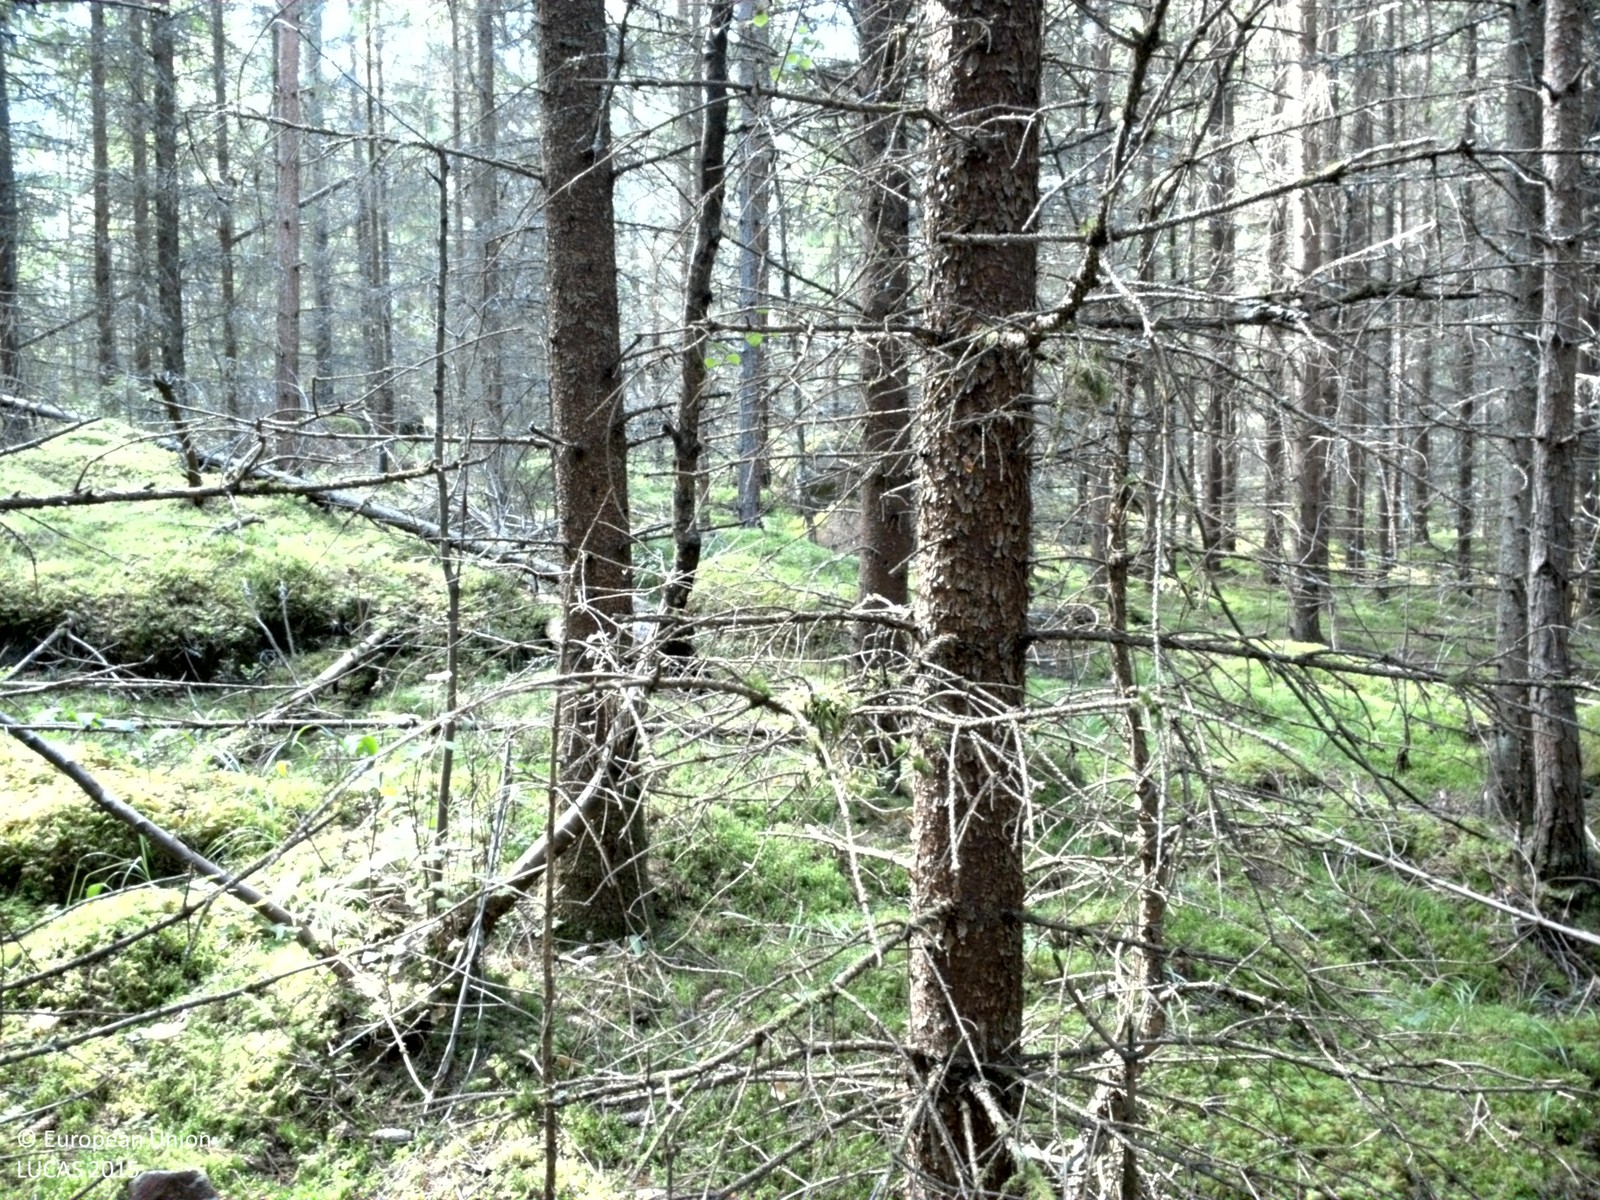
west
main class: Woodland
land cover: Spruce dominated coniferous woodland
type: boreal forest
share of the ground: > 75 %
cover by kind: coniferous forest trees 95 %, lichens and mosses 5 %
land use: Forestry
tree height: > 5 m
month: August
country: SE
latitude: 59.9606
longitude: 16.4557
